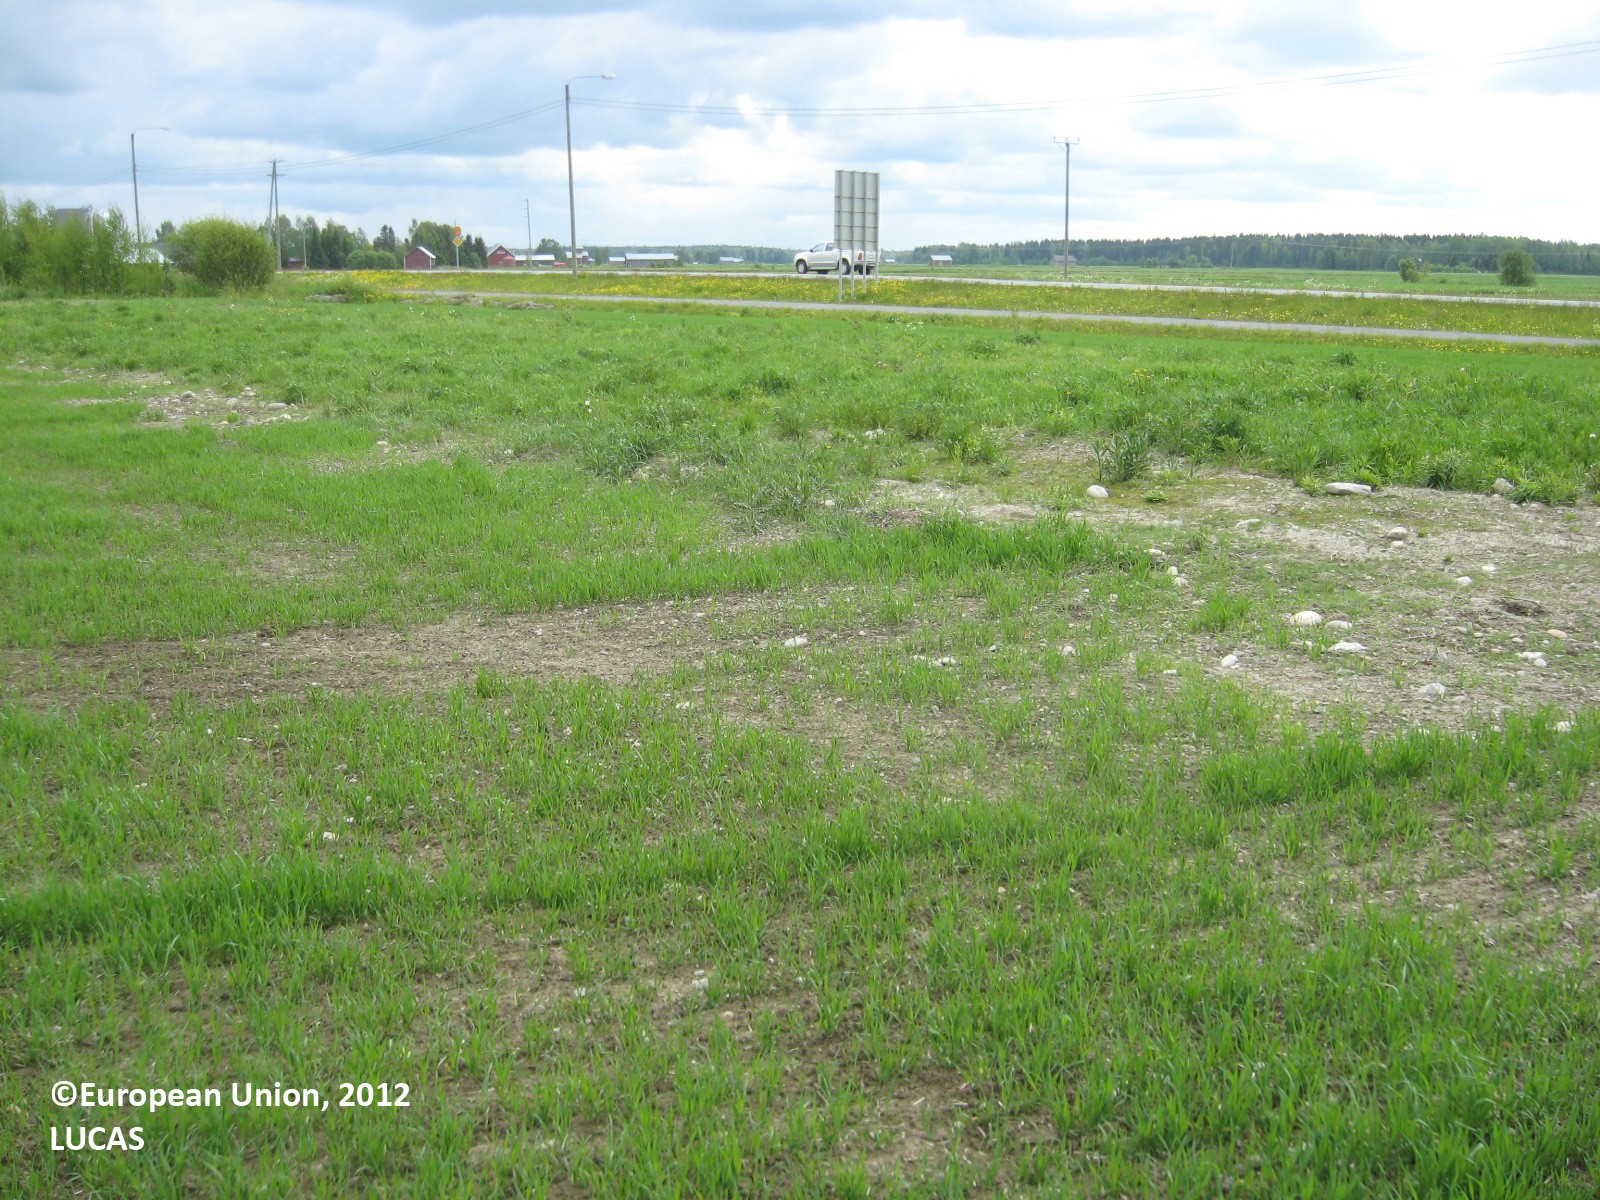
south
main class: Cropland
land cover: Oats
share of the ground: > 75 %
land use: Agriculture (excluding fallow land and kitchen gardens)
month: June
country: FI
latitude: 63.0238
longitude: 21.7997
